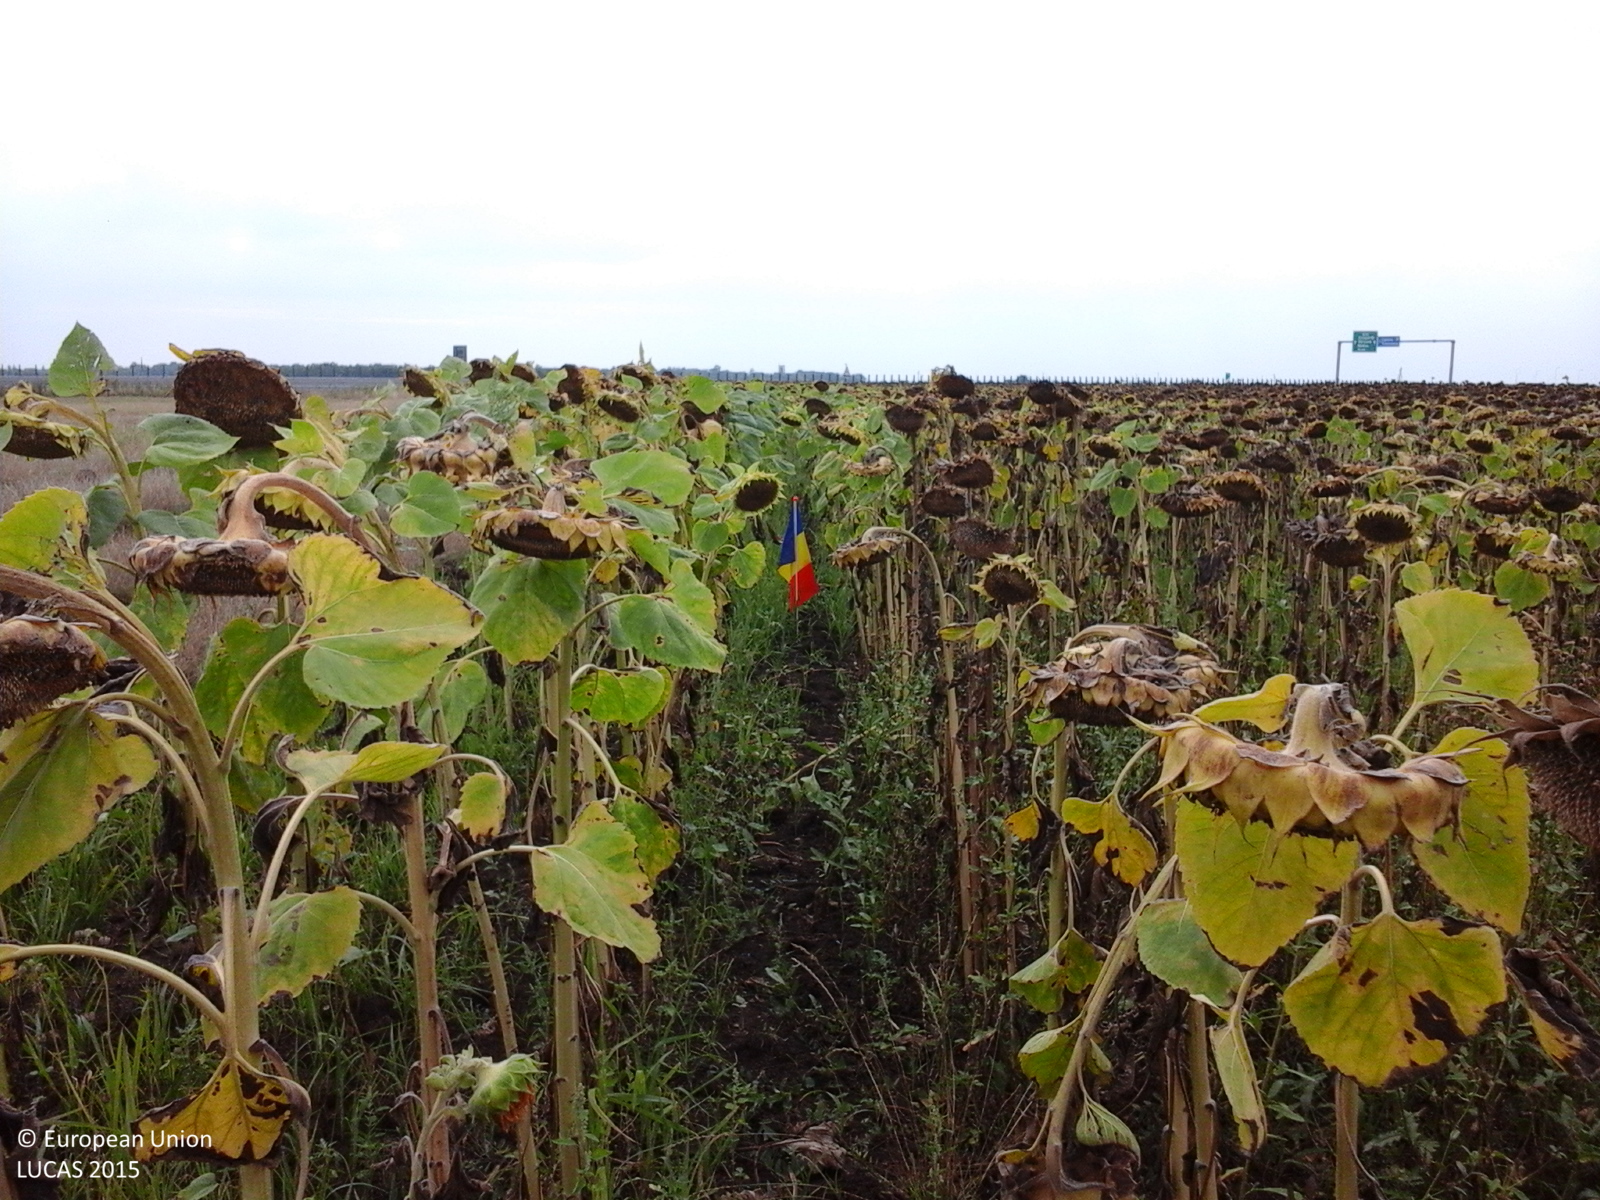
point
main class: Cropland
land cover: Sunflower
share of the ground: > 75 %
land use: Agriculture (excluding fallow land and kitchen gardens)
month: August
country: RO
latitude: 45.8565
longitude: 21.3273
